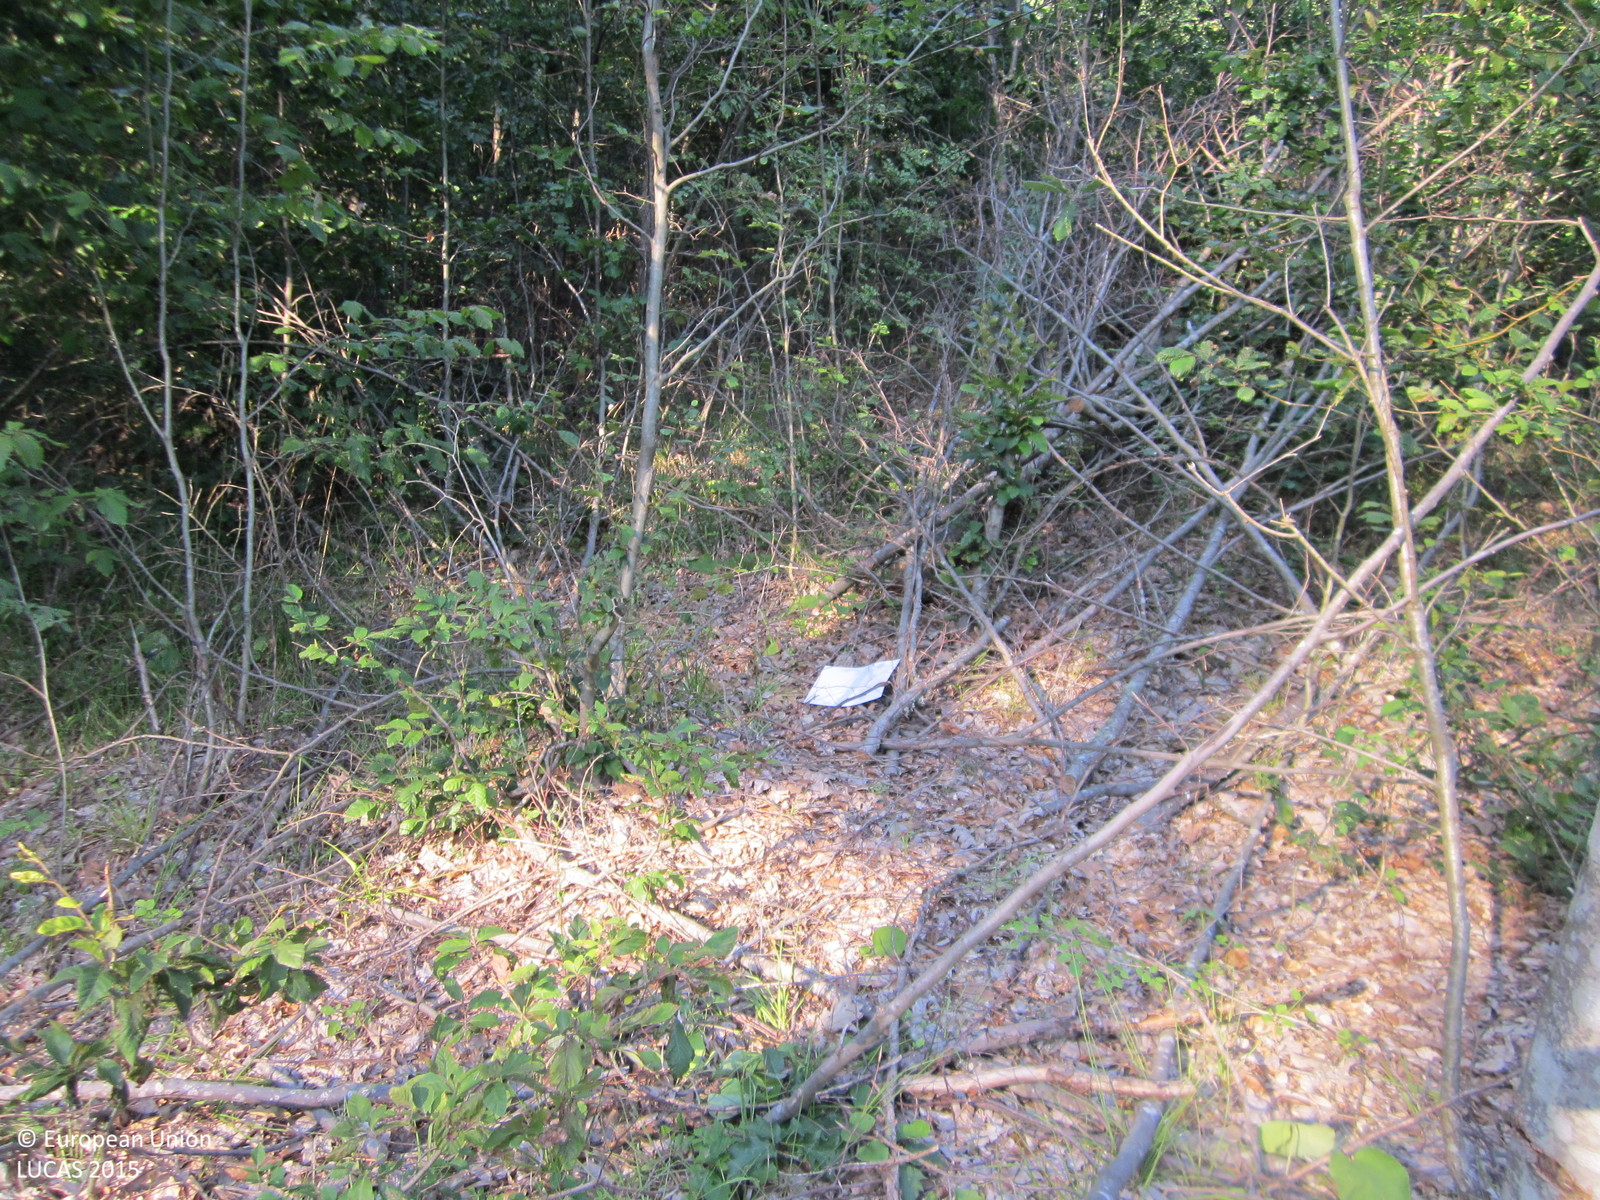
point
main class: Woodland
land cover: Broadleaved woodland
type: thermophilous deciduous forest
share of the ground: > 75 %
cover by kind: broadleaved forest trees 90 %, shrubs 5 %, herbaceous plants 5 %
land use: Forestry
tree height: > 5 m
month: August
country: BG
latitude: 42.1584
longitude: 27.6542
